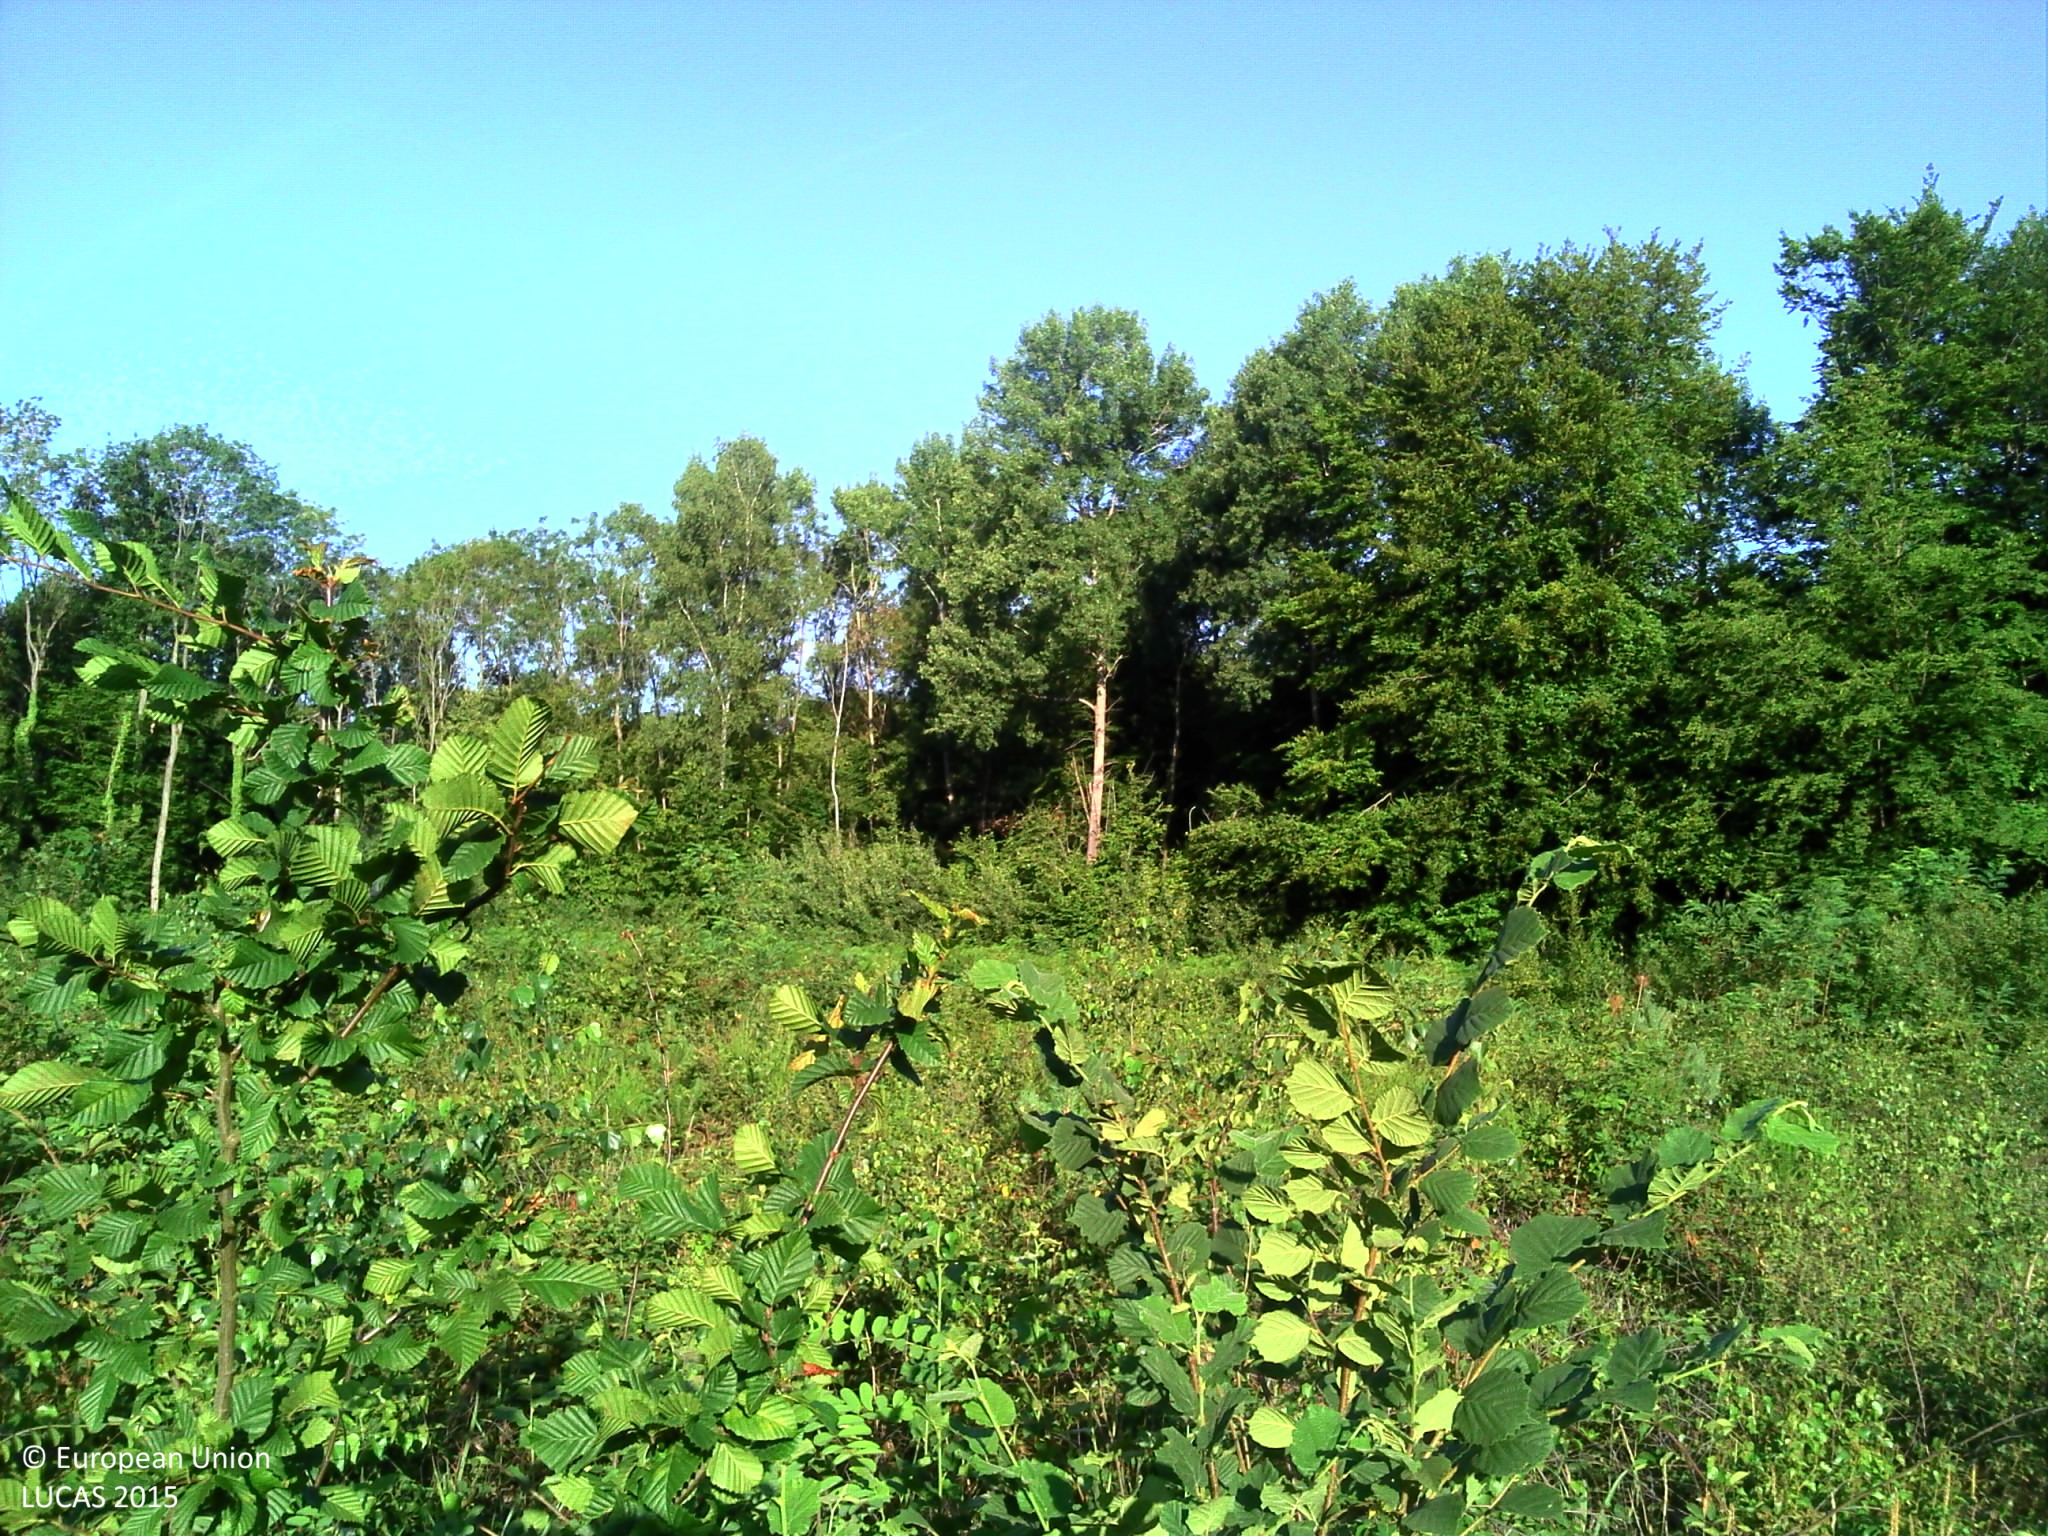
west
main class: Shrubland
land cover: Shrubland without tree cover
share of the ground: > 75 %
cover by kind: shrubs 65 %, herbaceous plants 35 %
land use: Semi-natural and natural areas not in use
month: July
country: FR
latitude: 49.2741
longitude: 2.5803
